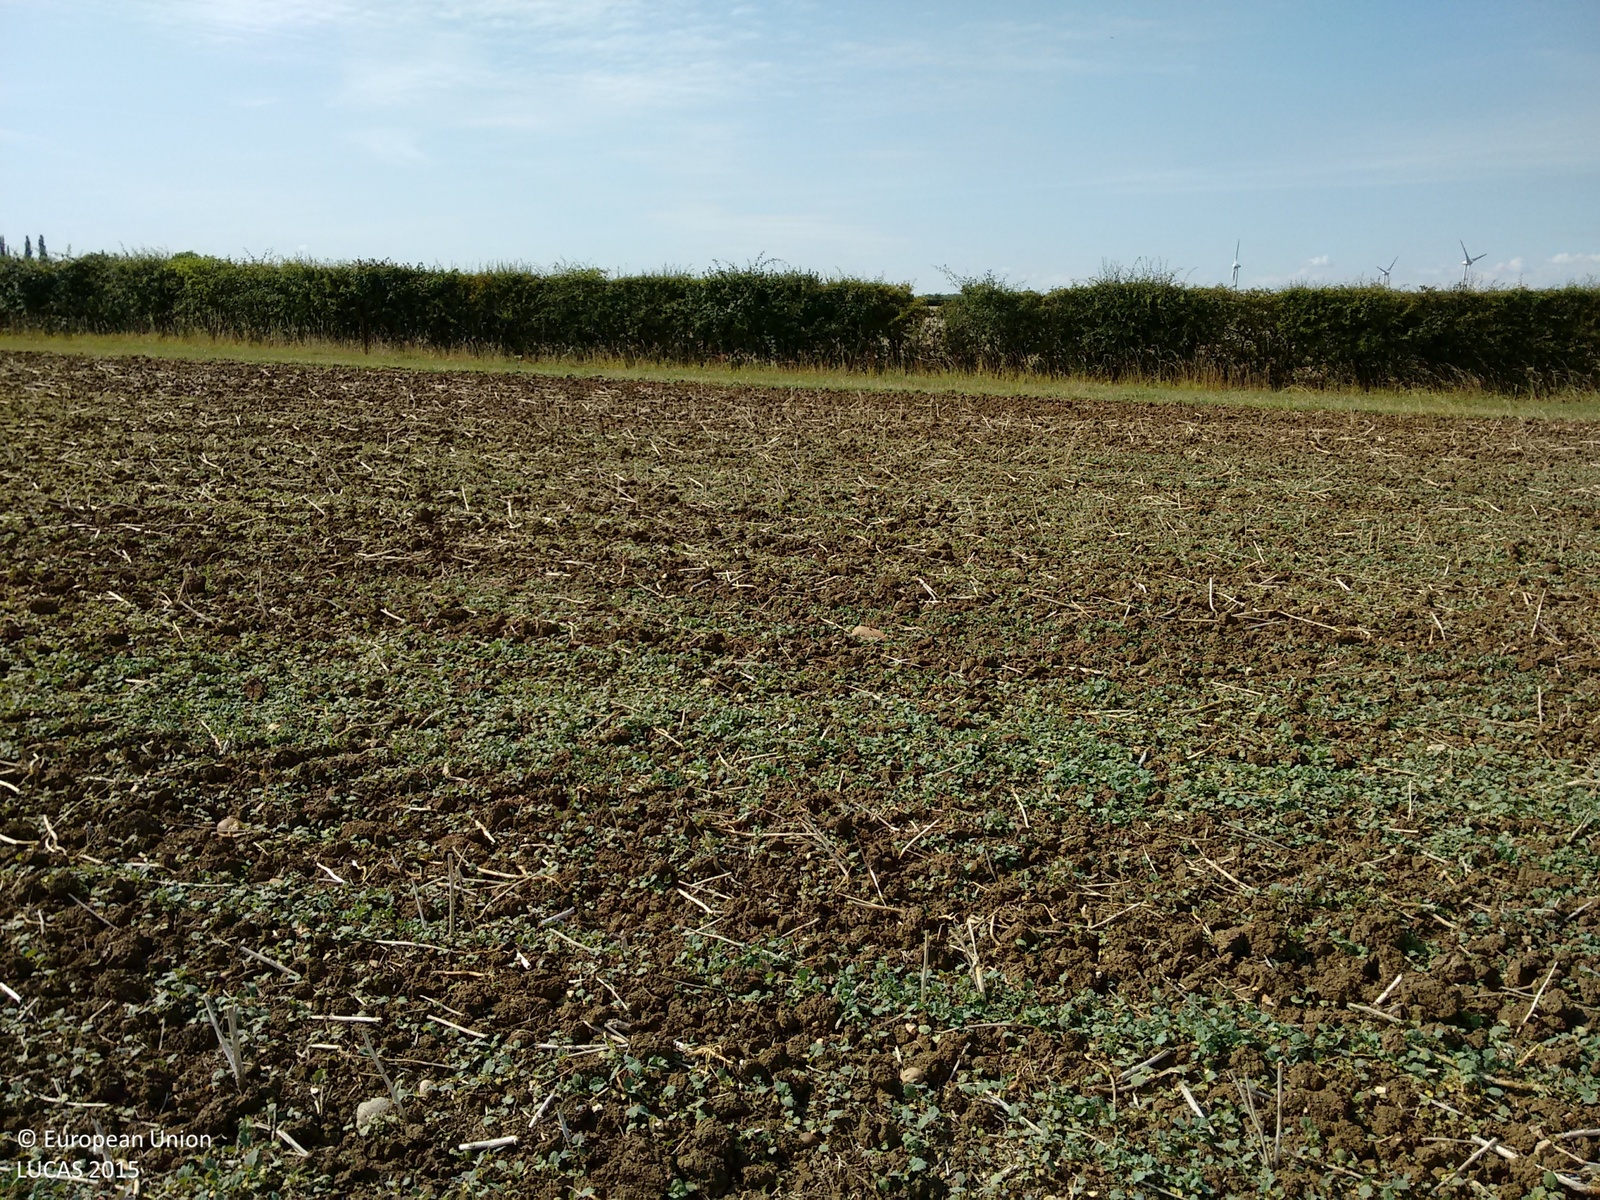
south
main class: Cropland
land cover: Rape and turnip rape
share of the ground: < 10 %
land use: Agriculture (excluding fallow land and kitchen gardens)
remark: Harvested field
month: August
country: GB
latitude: 52.3704
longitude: -0.6294
